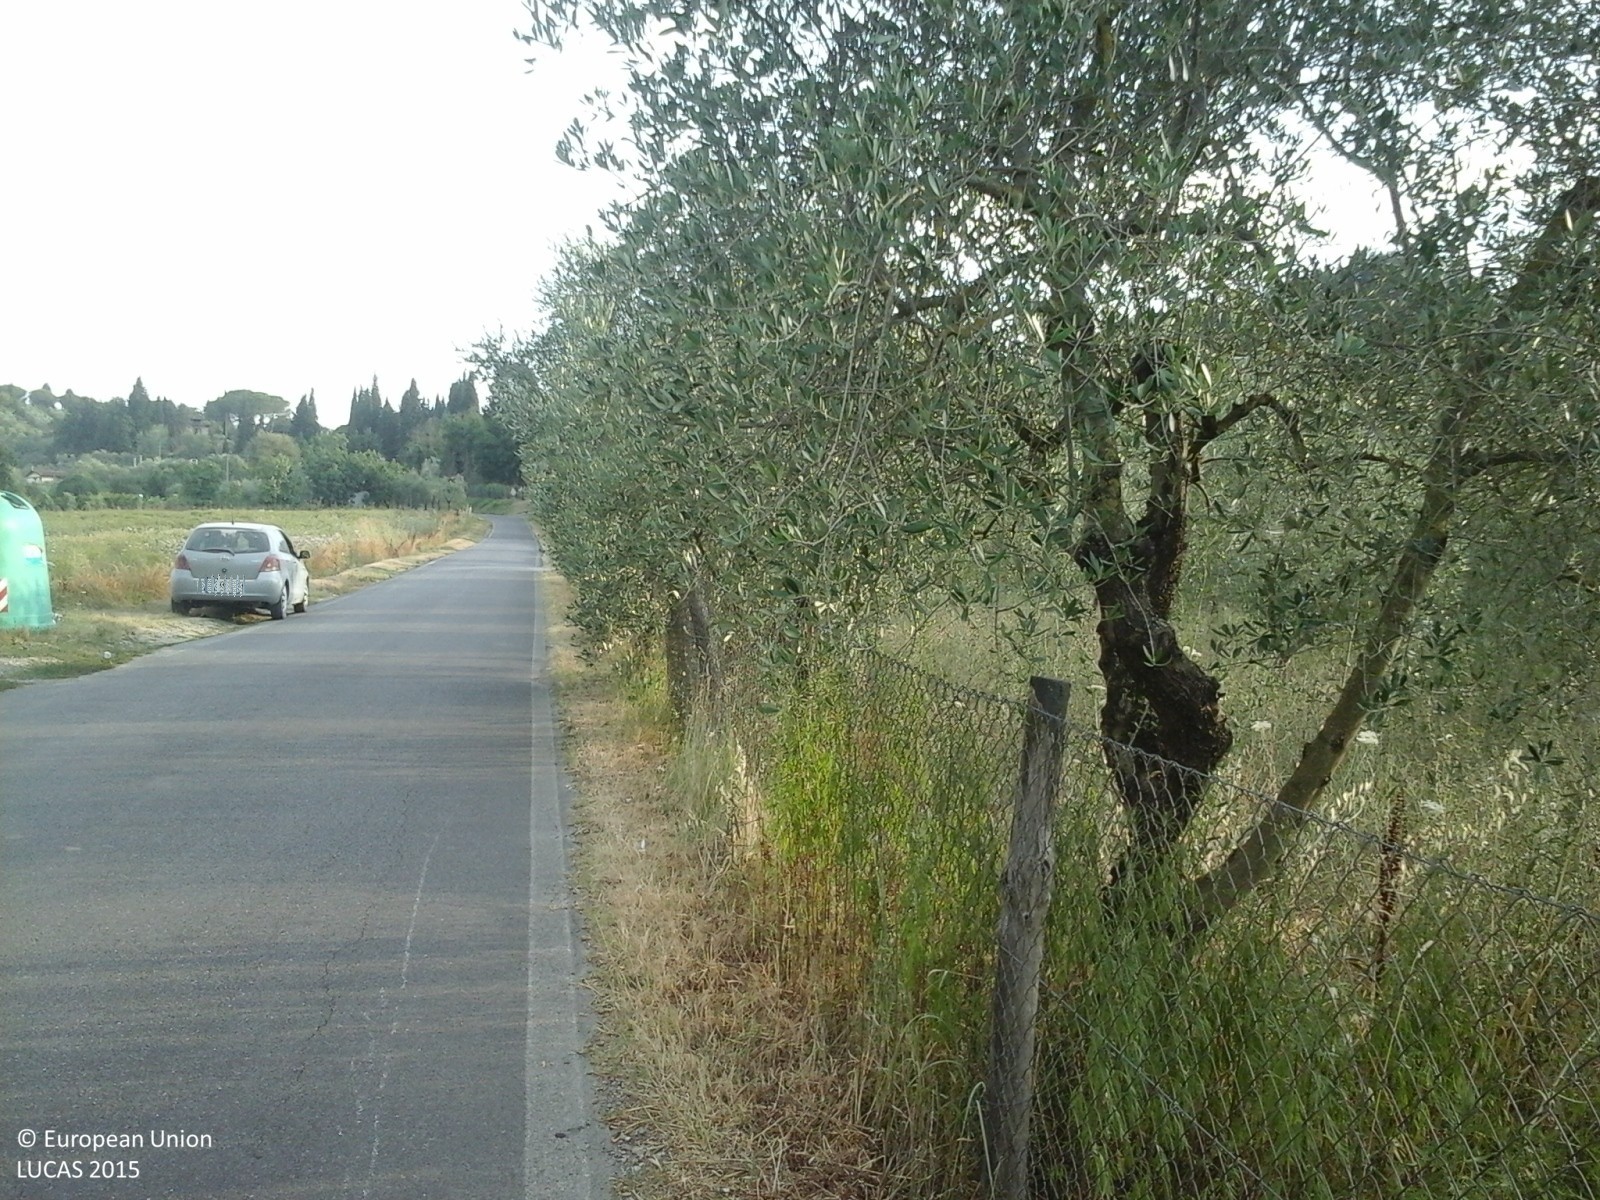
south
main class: Cropland
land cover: Olive groves
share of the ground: > 75 %
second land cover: Spontaneously vegetated surfaces
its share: > 75 %
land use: Agriculture (excluding fallow land and kitchen gardens)
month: July
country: IT
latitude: 43.6967
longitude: 10.9528
